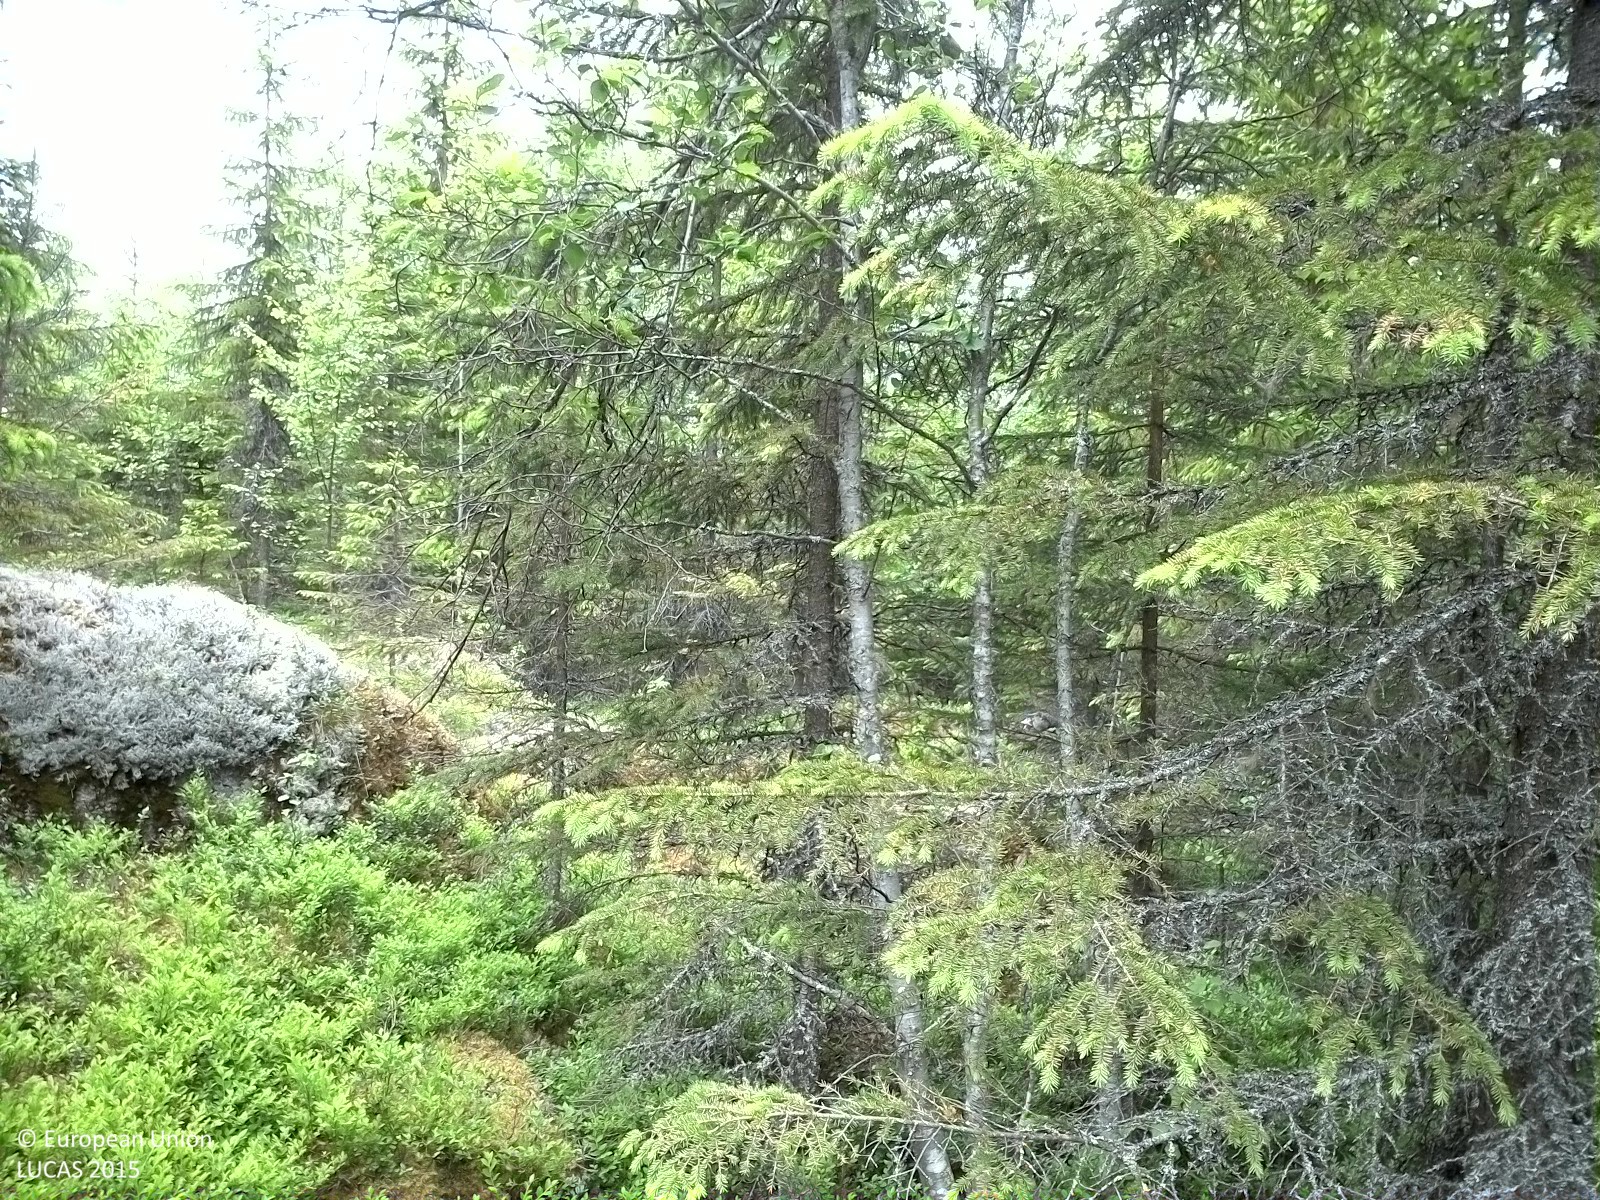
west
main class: Woodland
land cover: Spruce dominated coniferous woodland
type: boreal forest
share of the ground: 25 - 50 %
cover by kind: coniferous forest trees 45 %, shrubs 45 %, broadleaved forest trees 5 %, herbaceous plants 5 %
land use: Forestry
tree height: > 5 m
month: June
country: SE
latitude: 62.1224
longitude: 16.2115
